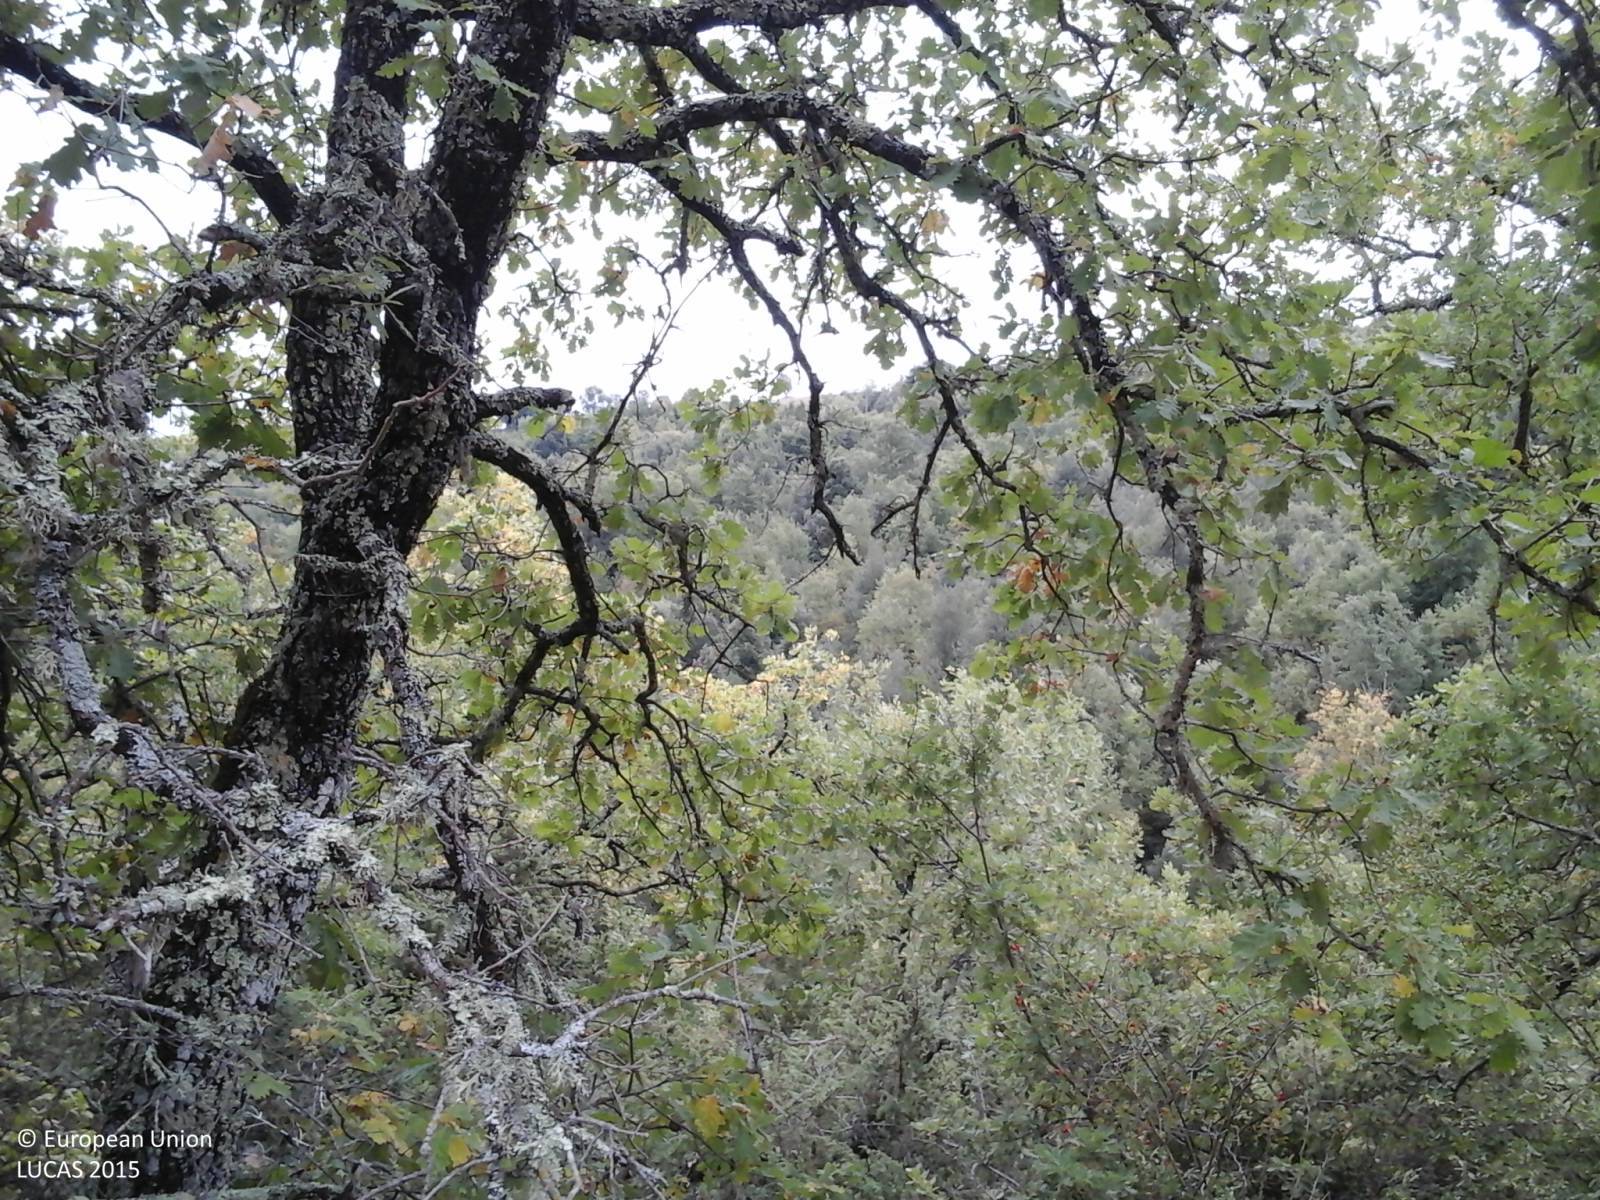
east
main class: Woodland
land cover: Broadleaved woodland
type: thermophilous deciduous forest
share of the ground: > 75 %
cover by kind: broadleaved forest trees 100 %
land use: Forestry
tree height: > 5 m
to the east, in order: Broadleaved woodland; Grassland without tree/shrub cover; Broadleaved woodland
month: September
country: IT
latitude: 42.9365
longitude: 12.2357
